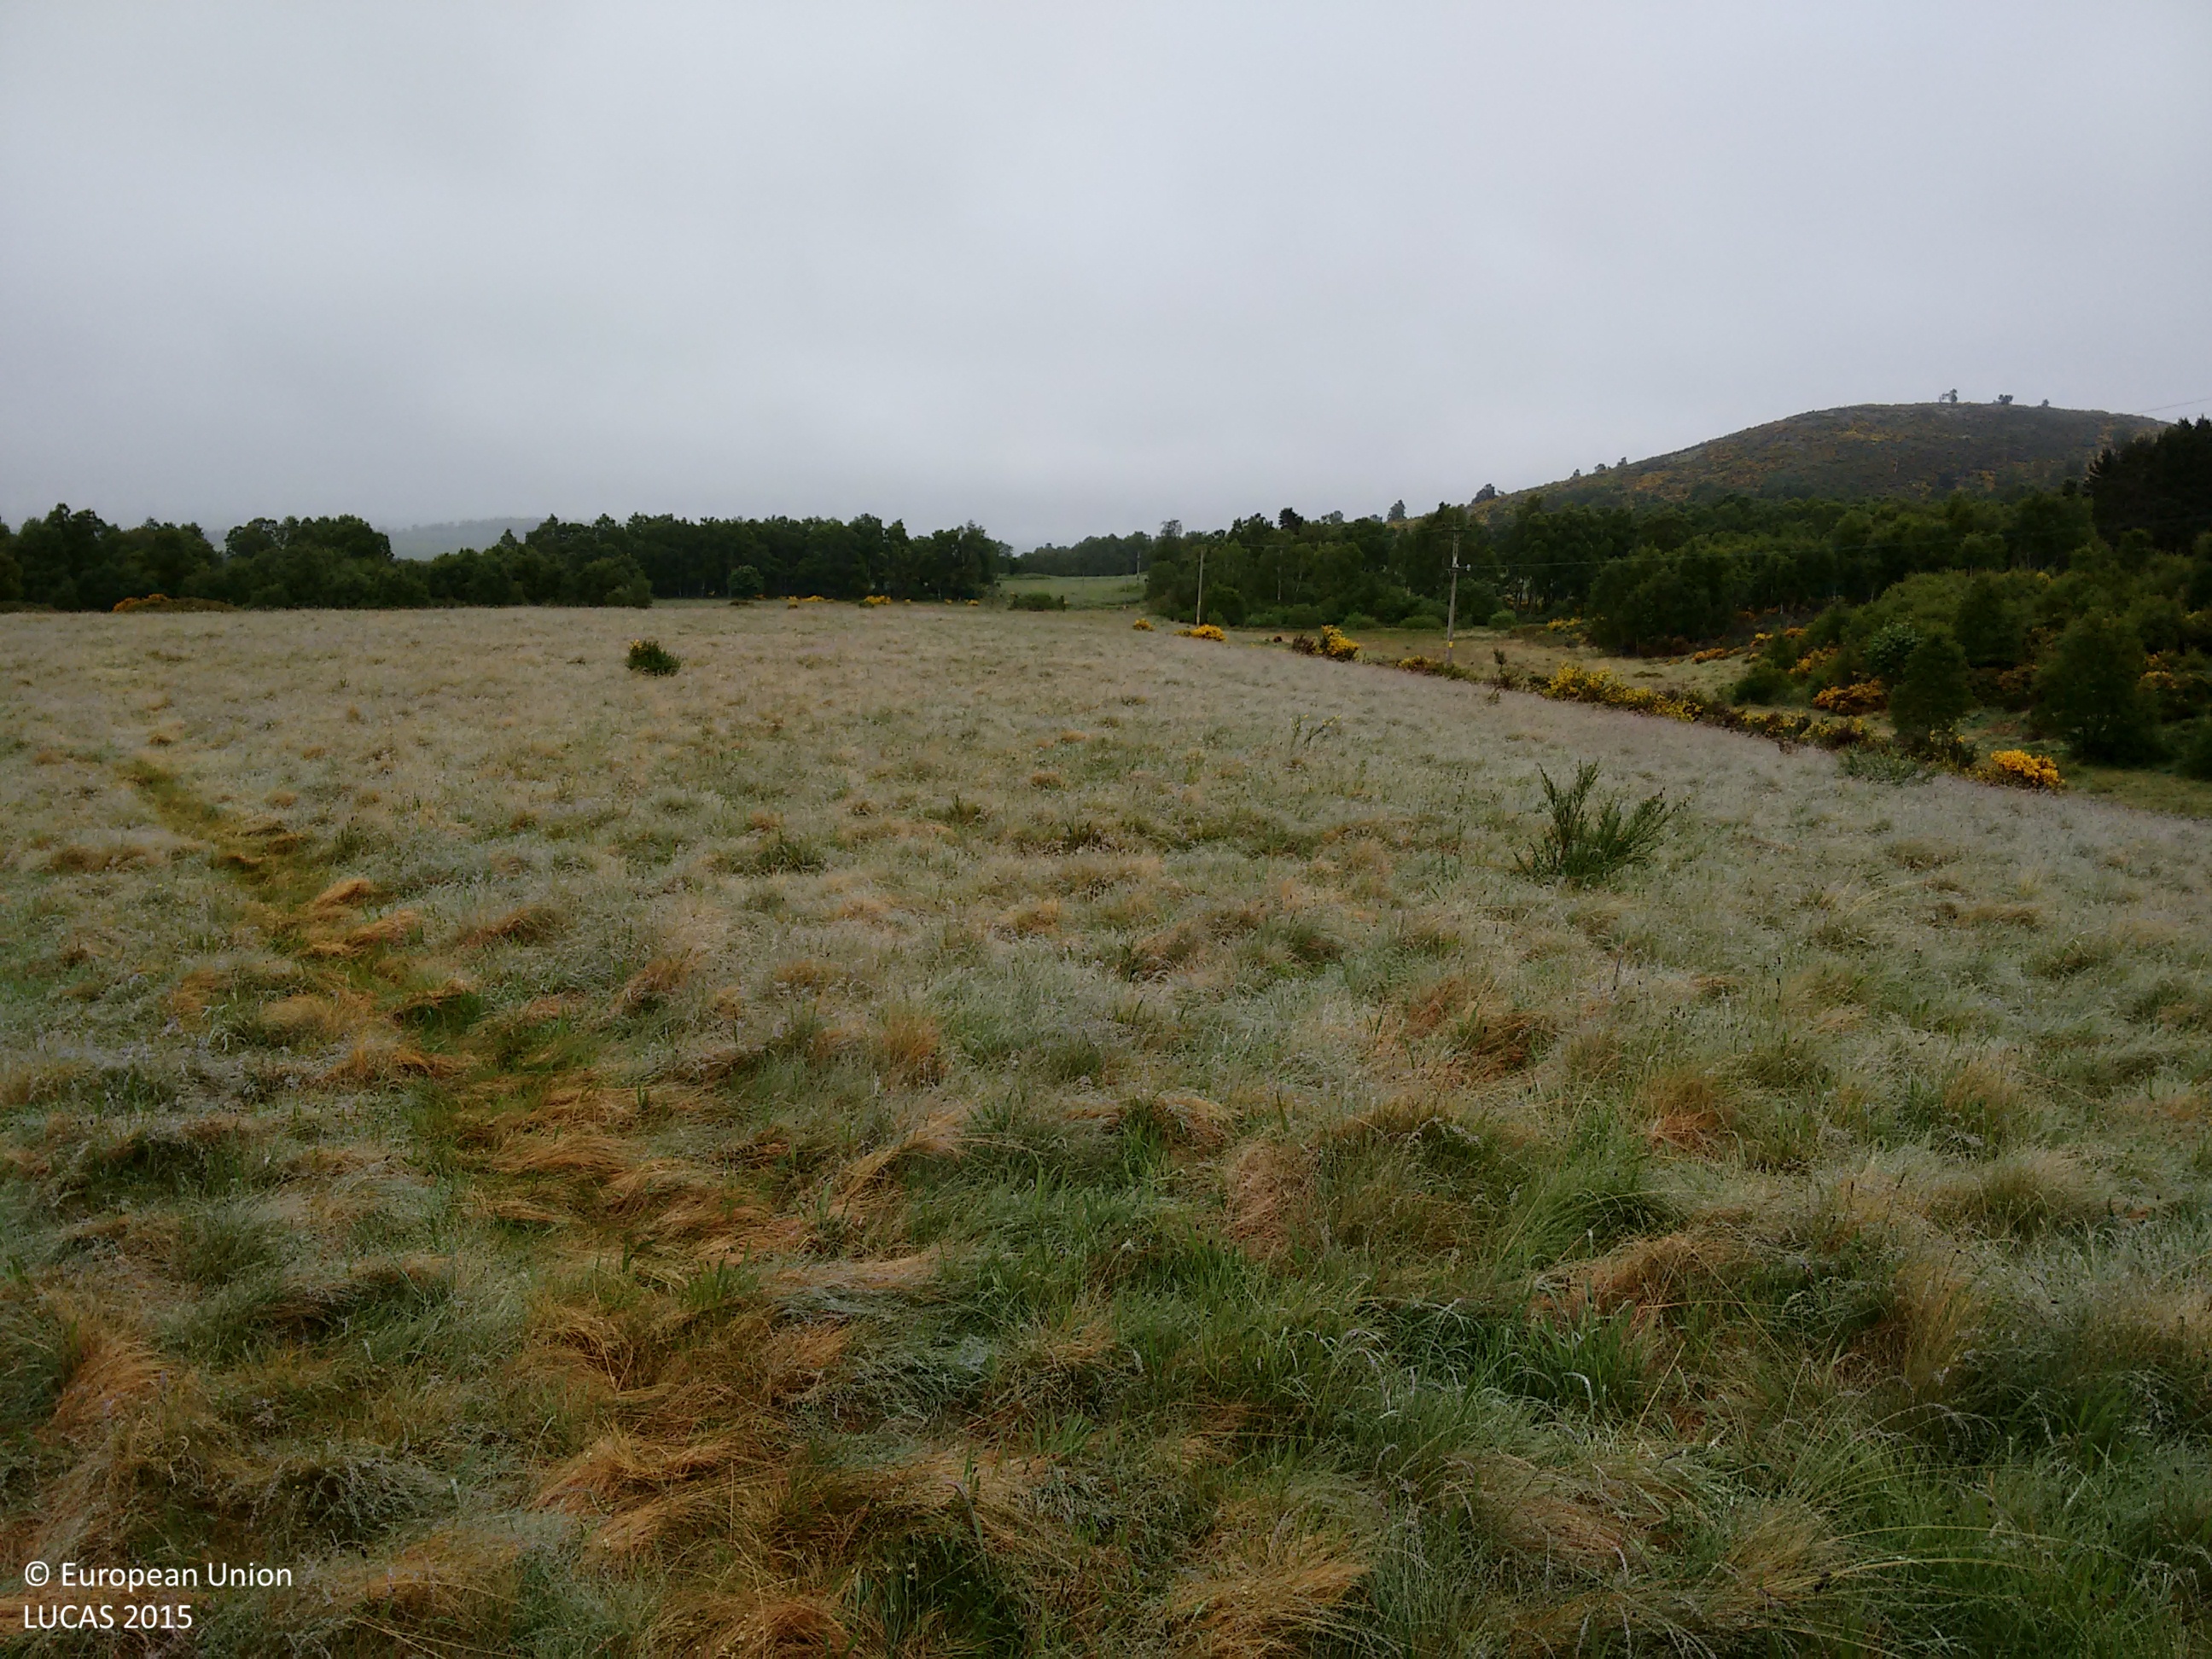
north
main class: Grassland
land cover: Grassland without tree/shrub cover
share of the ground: > 75 %
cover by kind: herbaceous plants 100 %
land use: Semi-natural and natural areas not in use
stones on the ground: < 10 %
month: June
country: GB
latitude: 57.0852
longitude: -2.8820
